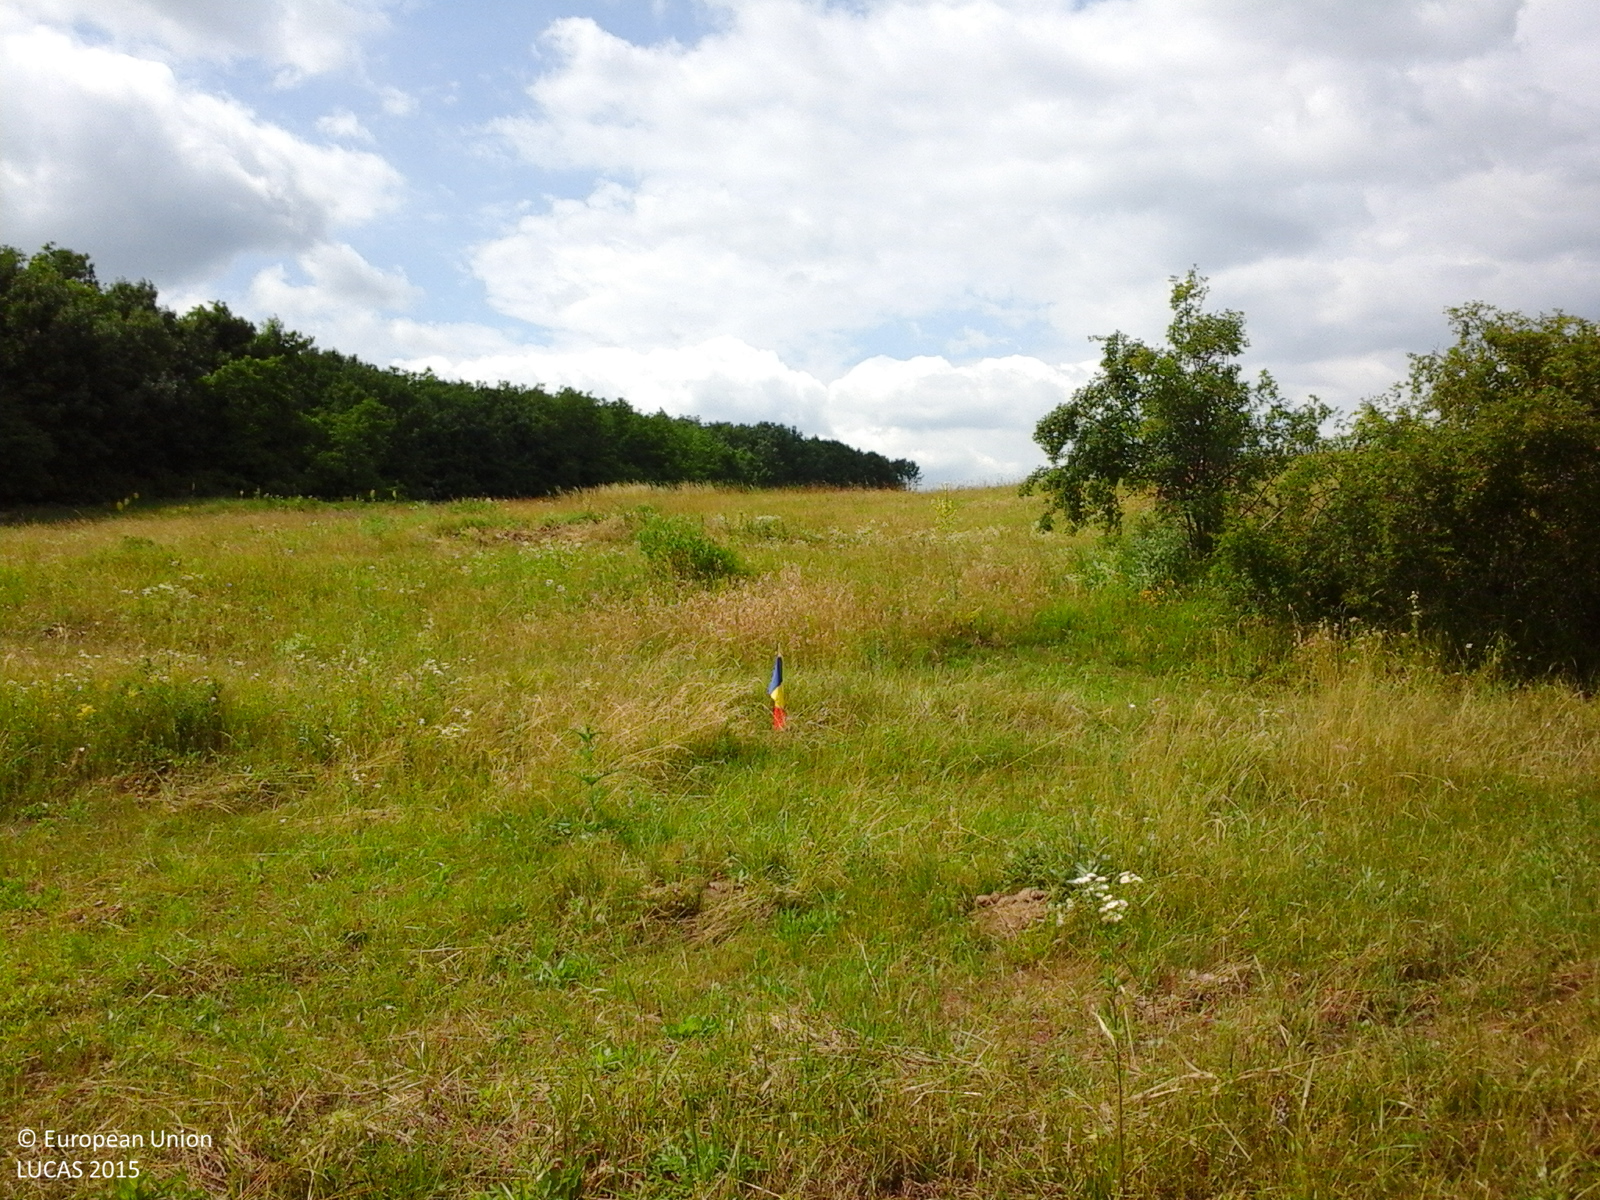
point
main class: Grassland
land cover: Grassland without tree/shrub cover
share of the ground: > 75 %
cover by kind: herbaceous plants 100 %
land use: Agriculture (excluding fallow land and kitchen gardens)
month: June
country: RO
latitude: 46.7297
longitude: 27.4221
